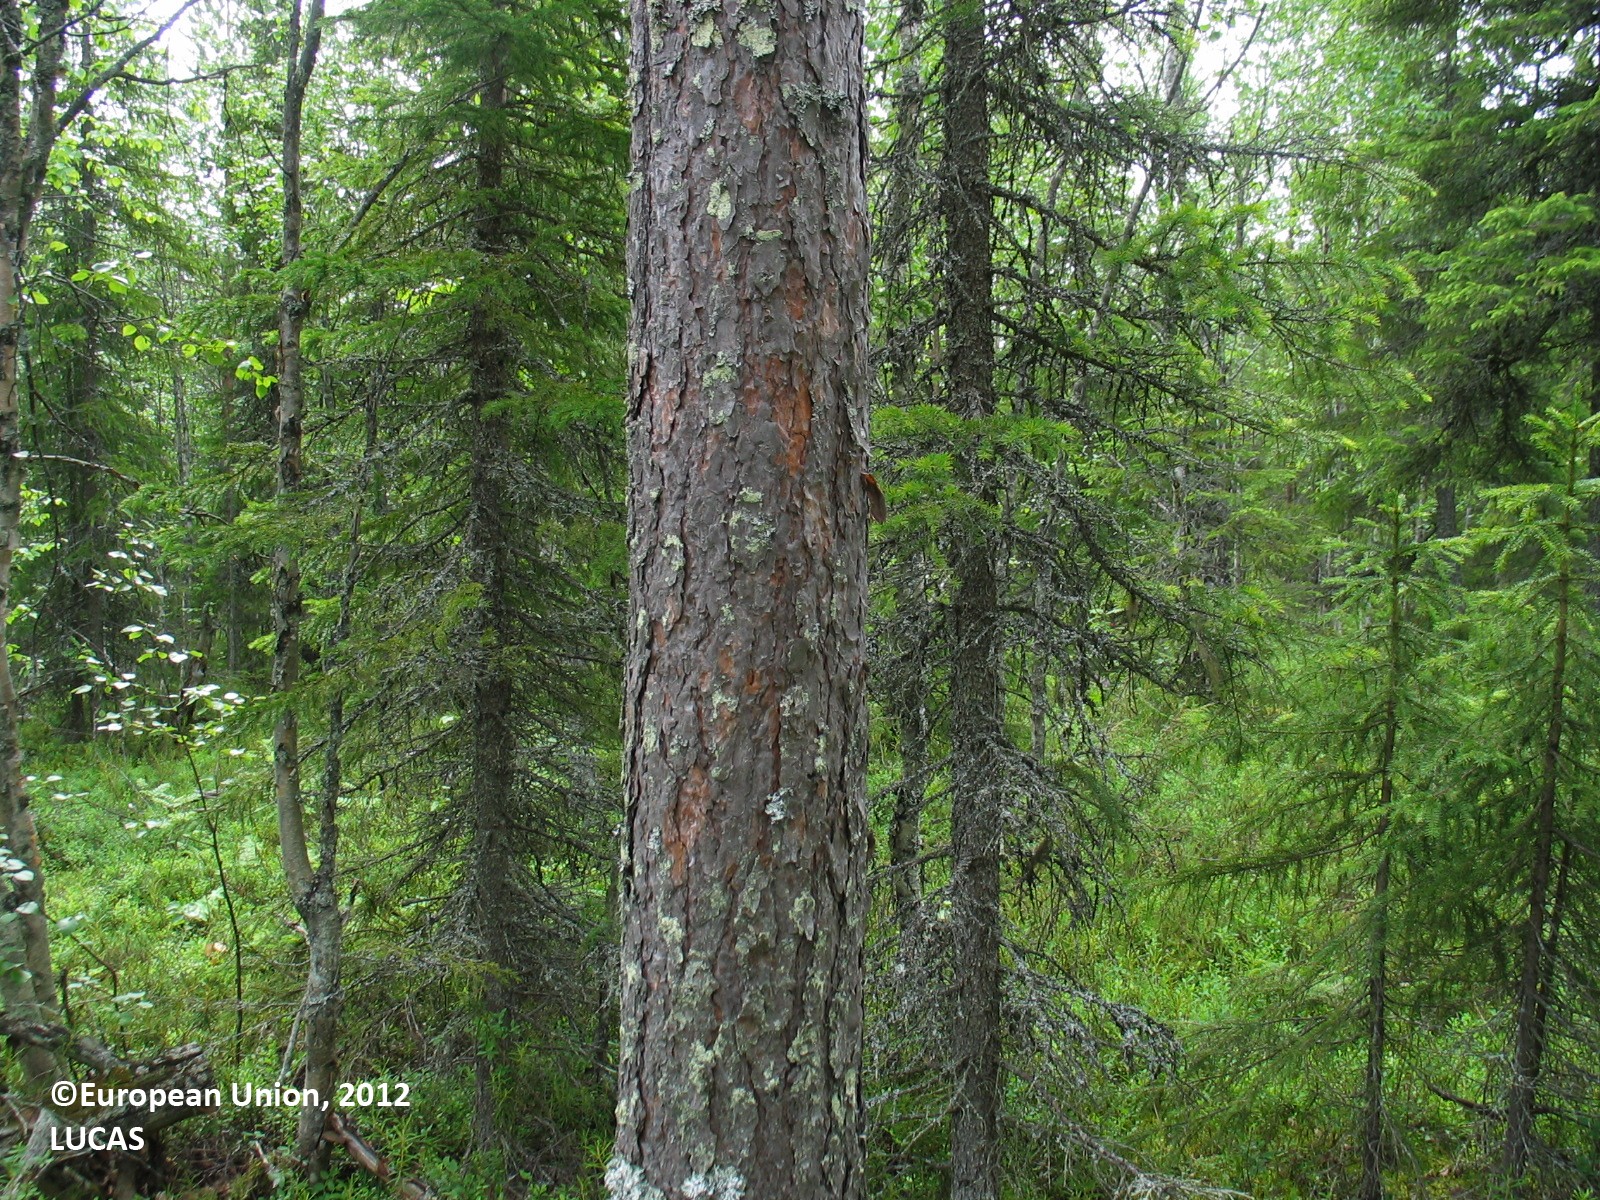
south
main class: Woodland
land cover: Other mixed woodland
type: mire and swamp forests
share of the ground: 25 - 50 %
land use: Forestry
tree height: > 5 m
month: July
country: FI
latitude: 66.0442
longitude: 25.4079
